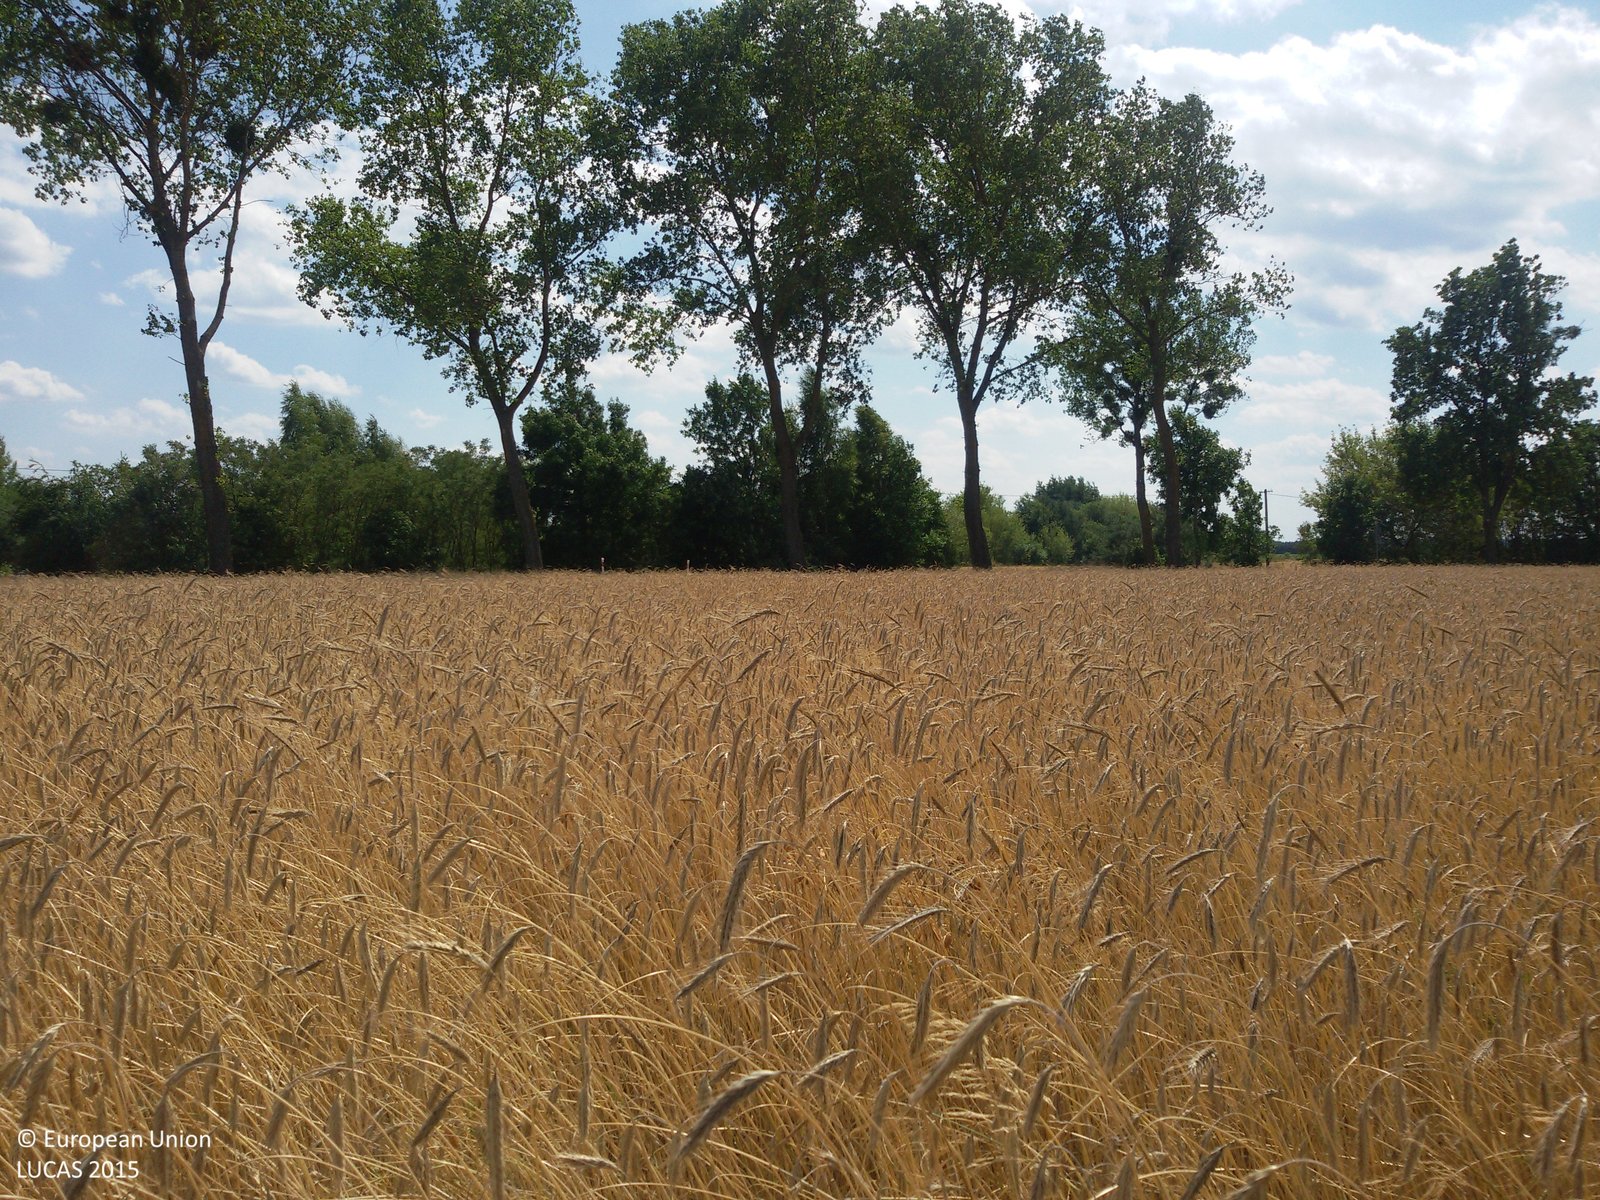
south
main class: Cropland
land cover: Rye
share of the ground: > 75 %
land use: Agriculture (excluding fallow land and kitchen gardens)
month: July
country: PL
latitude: 51.5458
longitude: 23.5097
